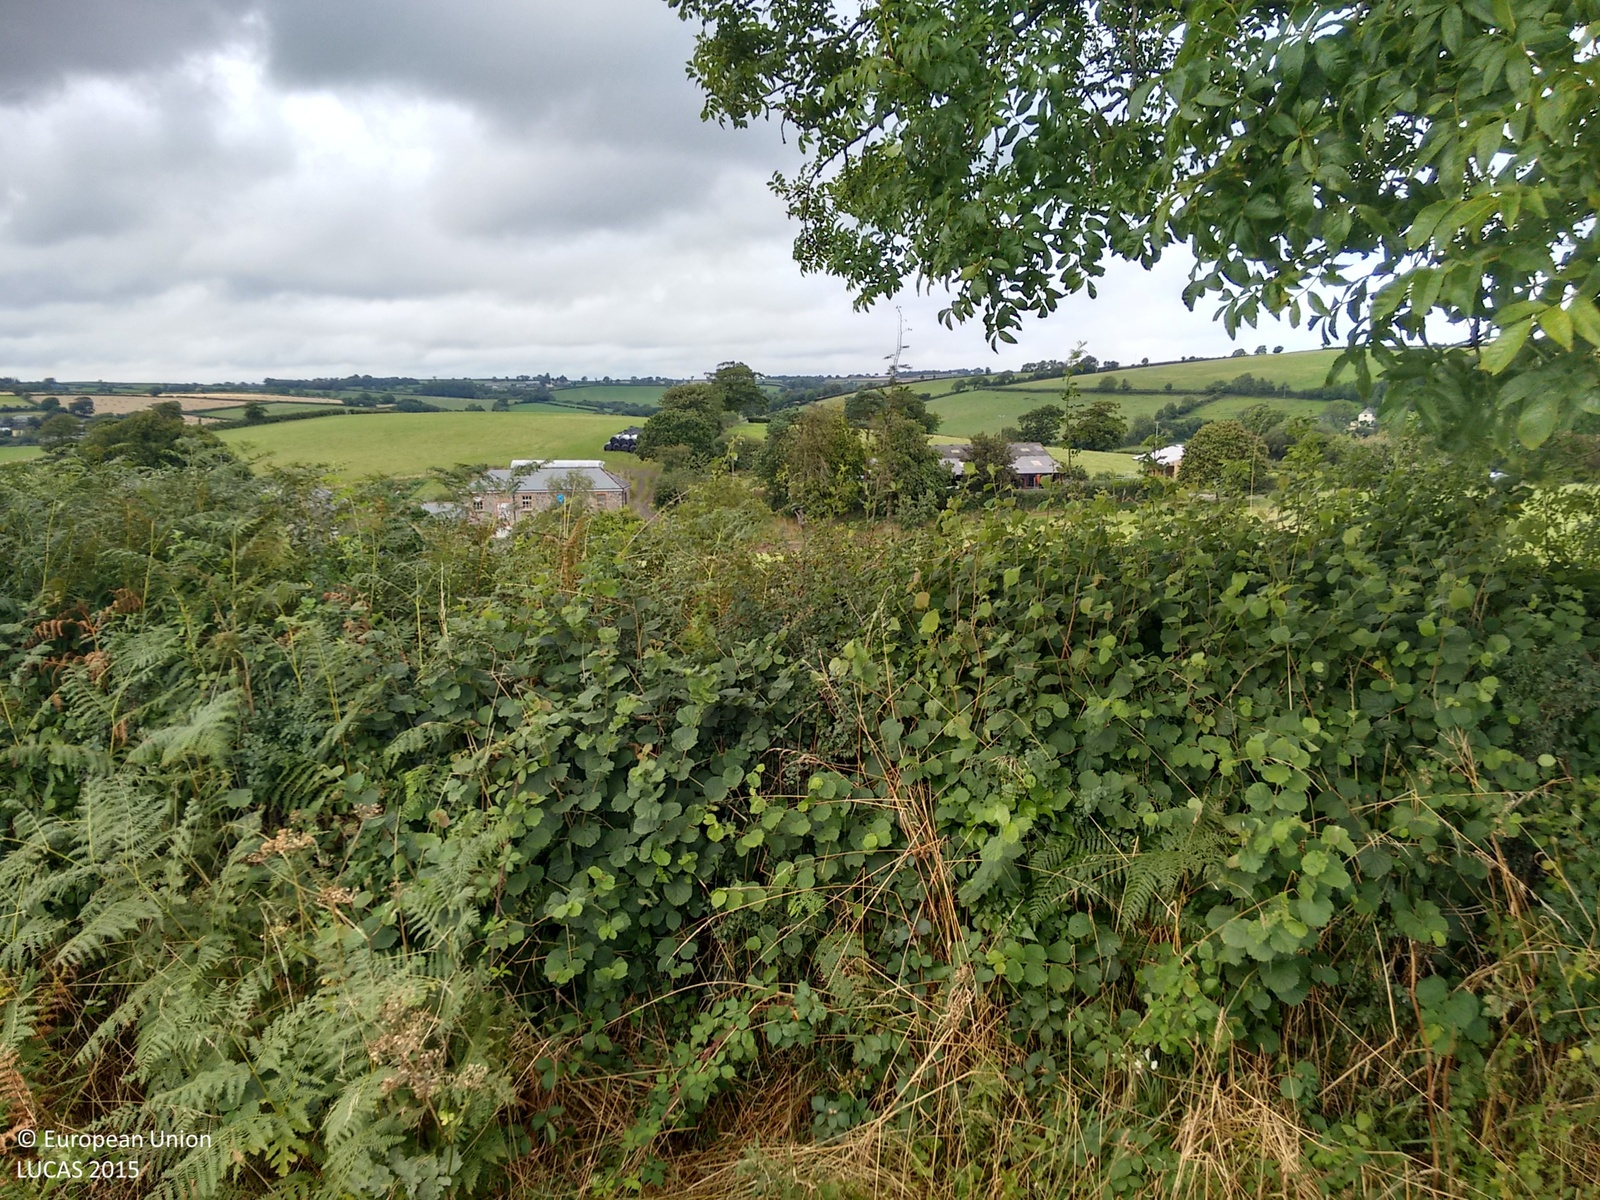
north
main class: Cropland
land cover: Barley
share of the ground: > 75 %
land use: Agriculture (excluding fallow land and kitchen gardens)
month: August
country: GB
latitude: 50.8581
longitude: -3.7701
